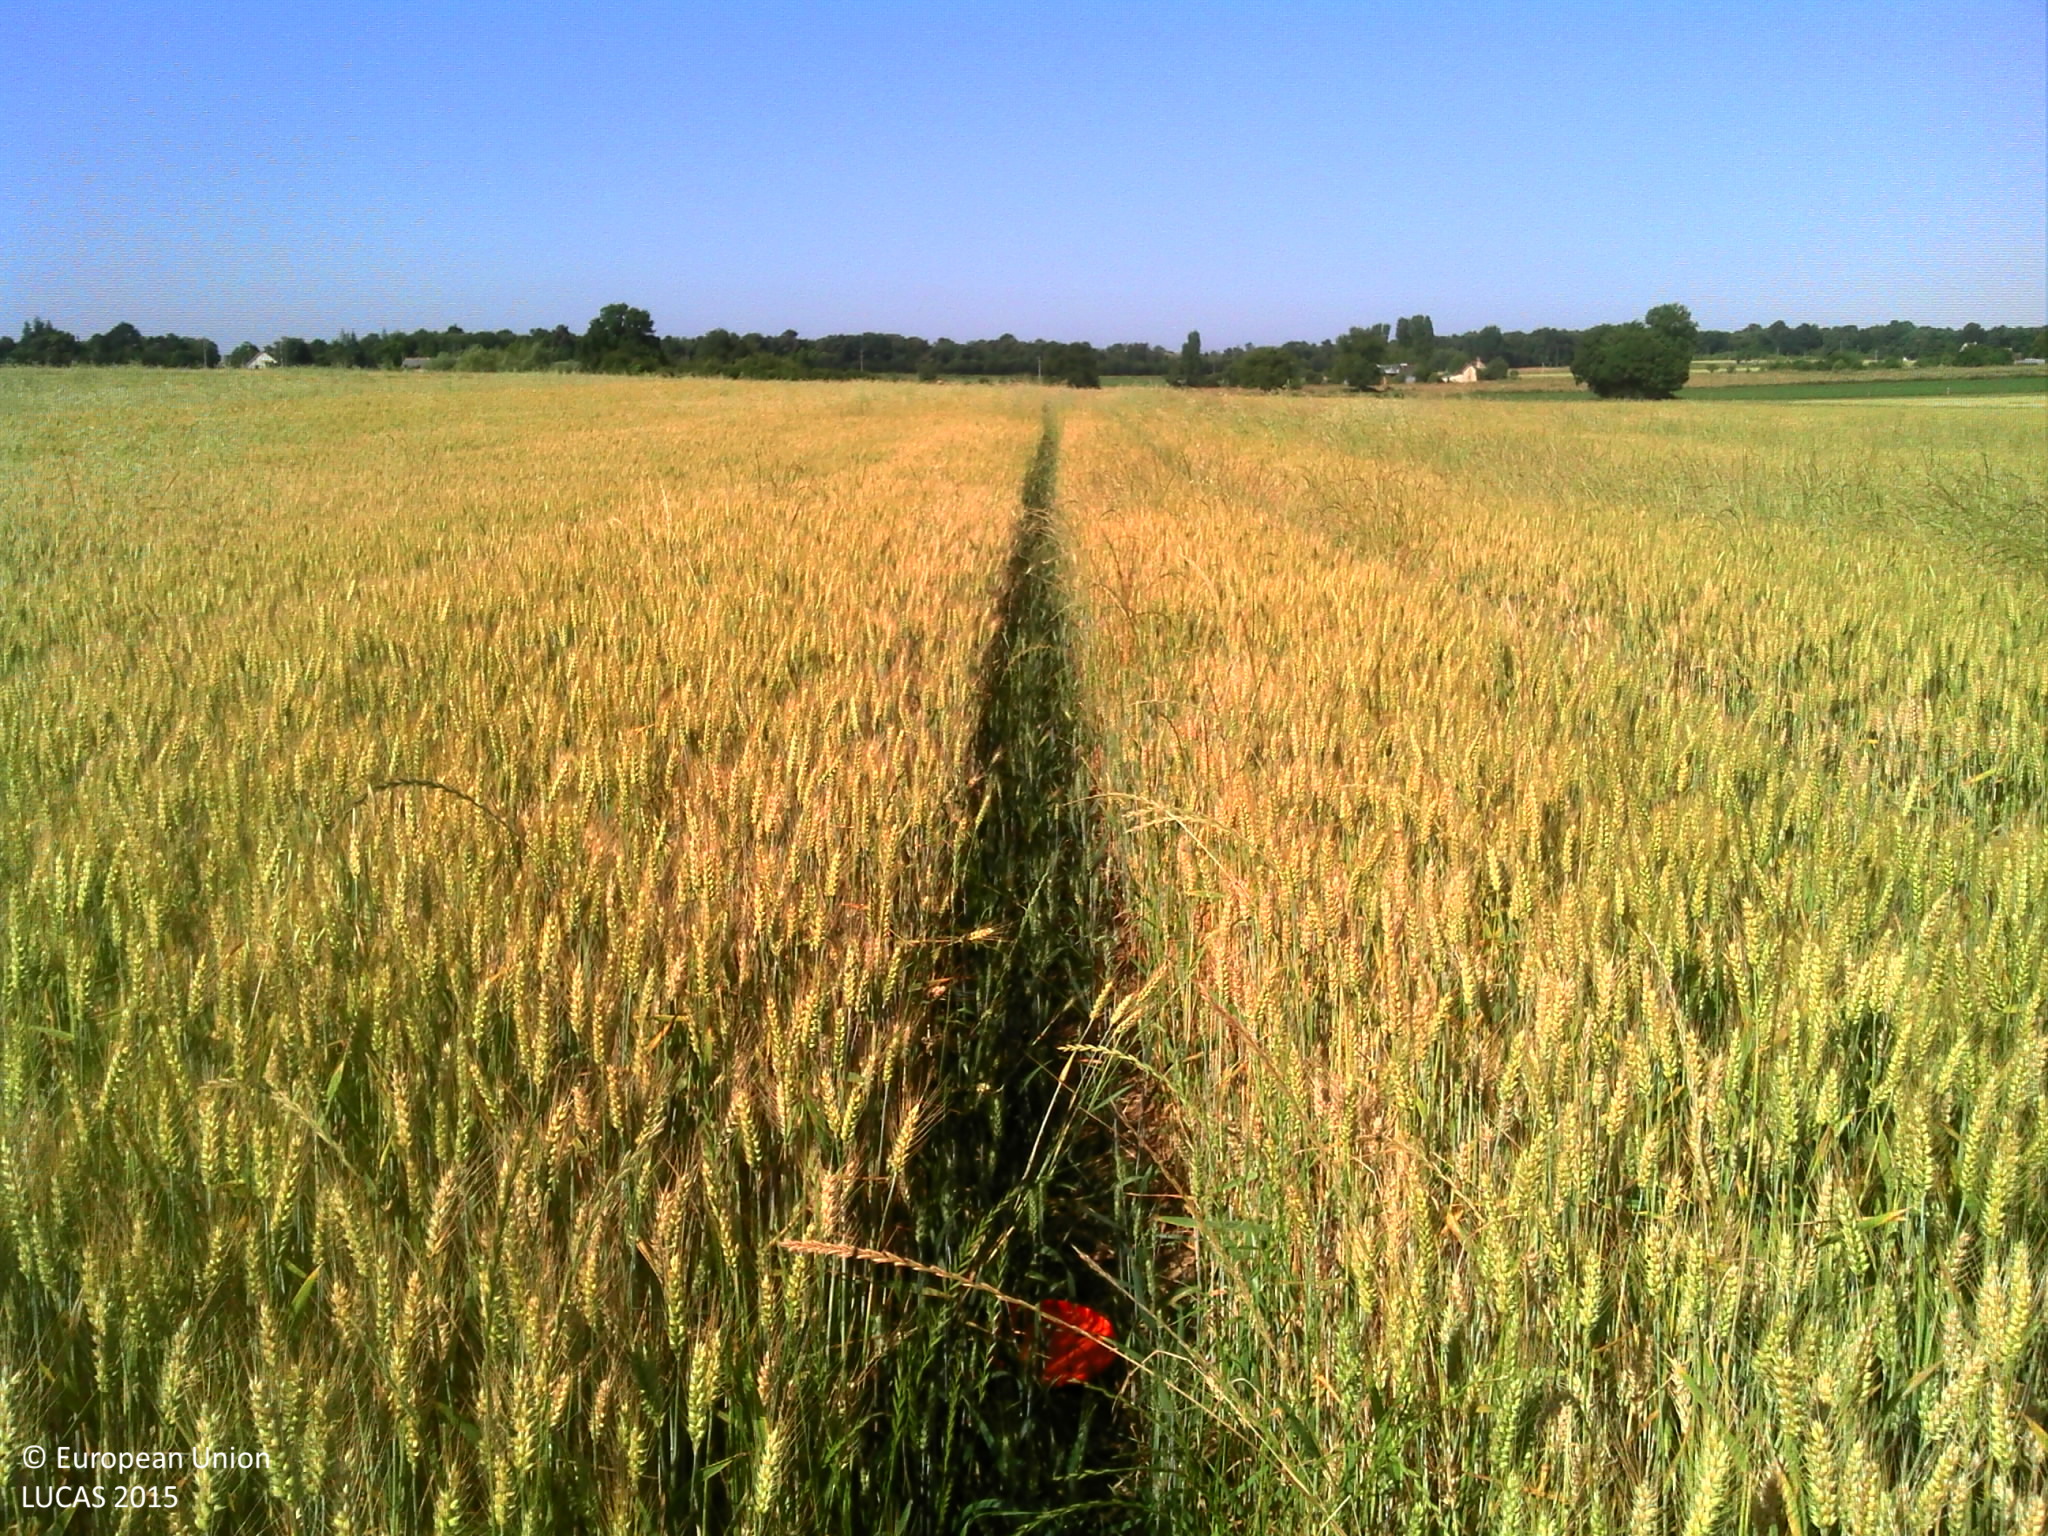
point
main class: Cropland
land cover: Durum wheat
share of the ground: > 75 %
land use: Agriculture (excluding fallow land and kitchen gardens)
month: June
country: FR
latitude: 47.5032
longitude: 0.4861
